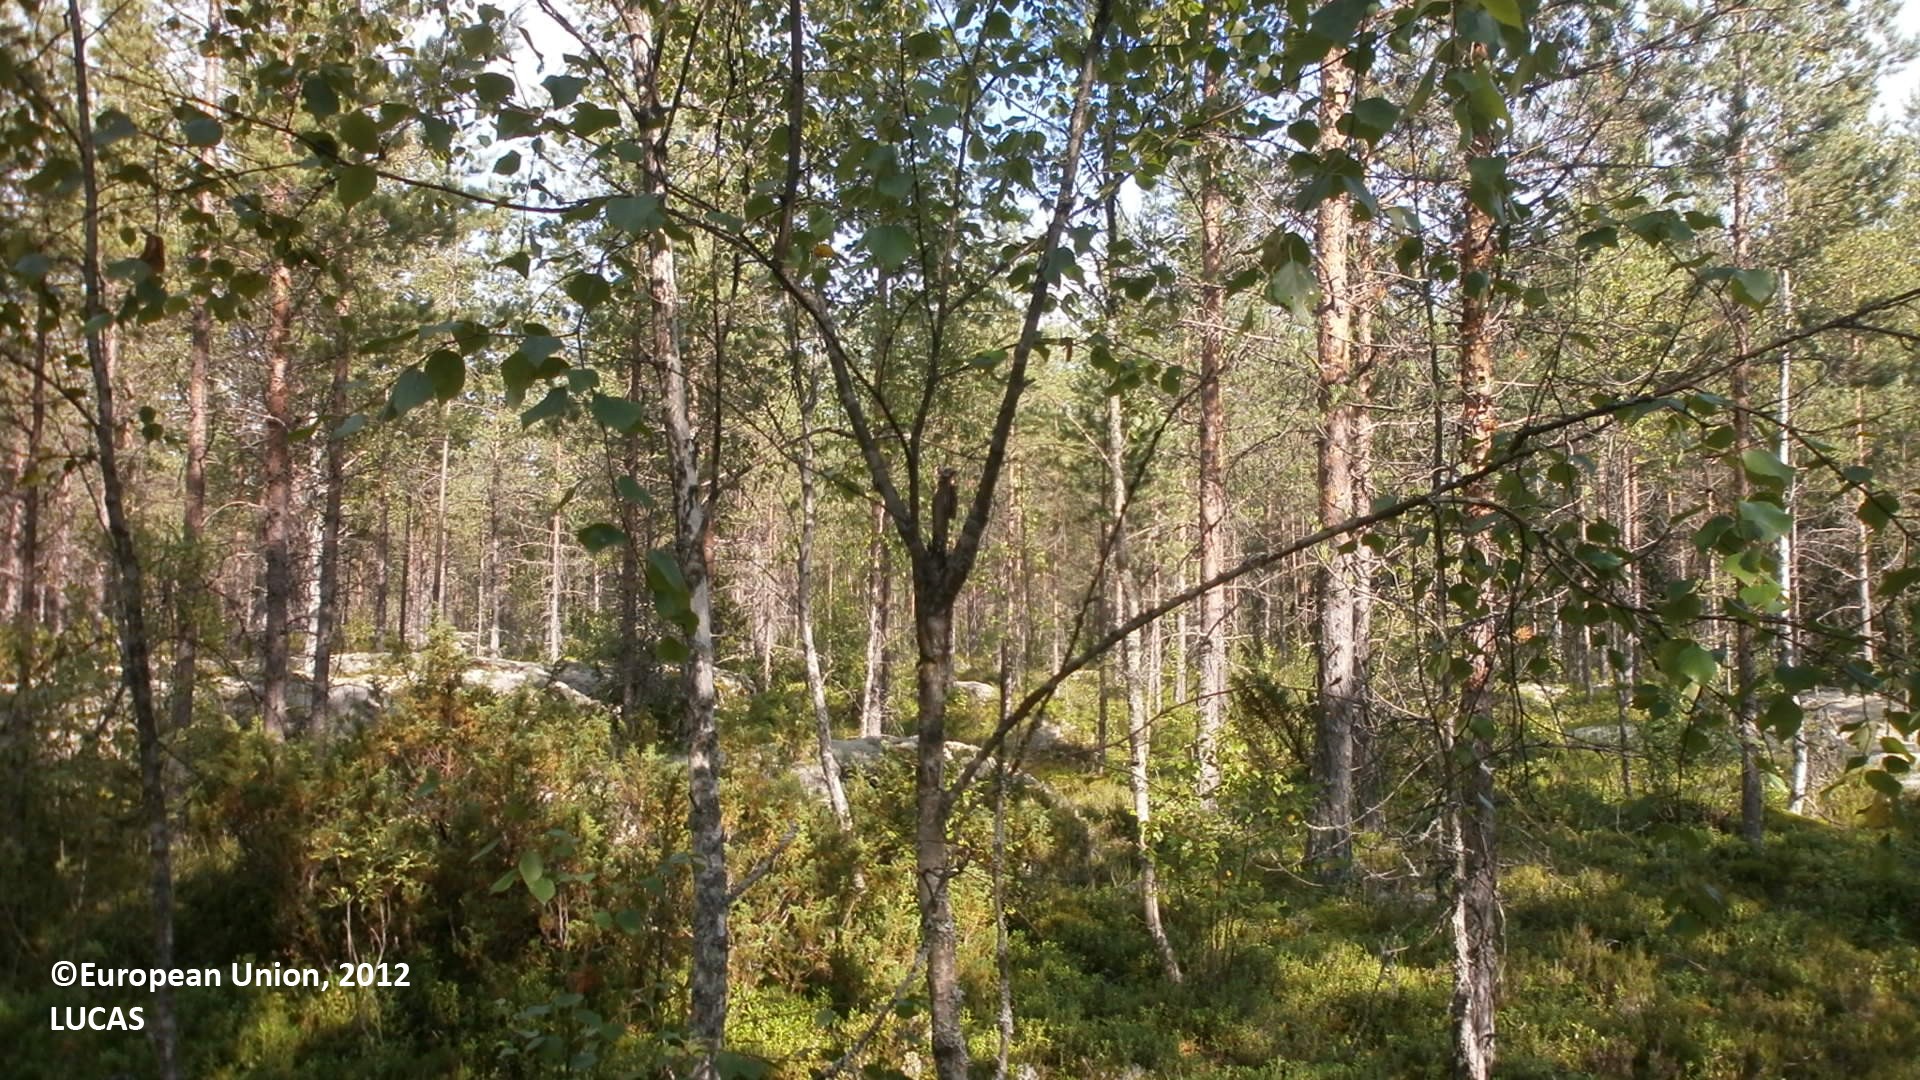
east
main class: Woodland
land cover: Pine dominated coniferous woodland
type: boreal forest
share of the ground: 50 - 75 %
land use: Forestry
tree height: > 5 m
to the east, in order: Pine dominated coniferous woodland; Shrubland with sparse tree cover; Pine dominated coniferous woodland; Spruce dominated coniferous woodland; Tracks; Spruce dominated coniferous woodland
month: July
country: FI
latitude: 64.1814
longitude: 24.3729
